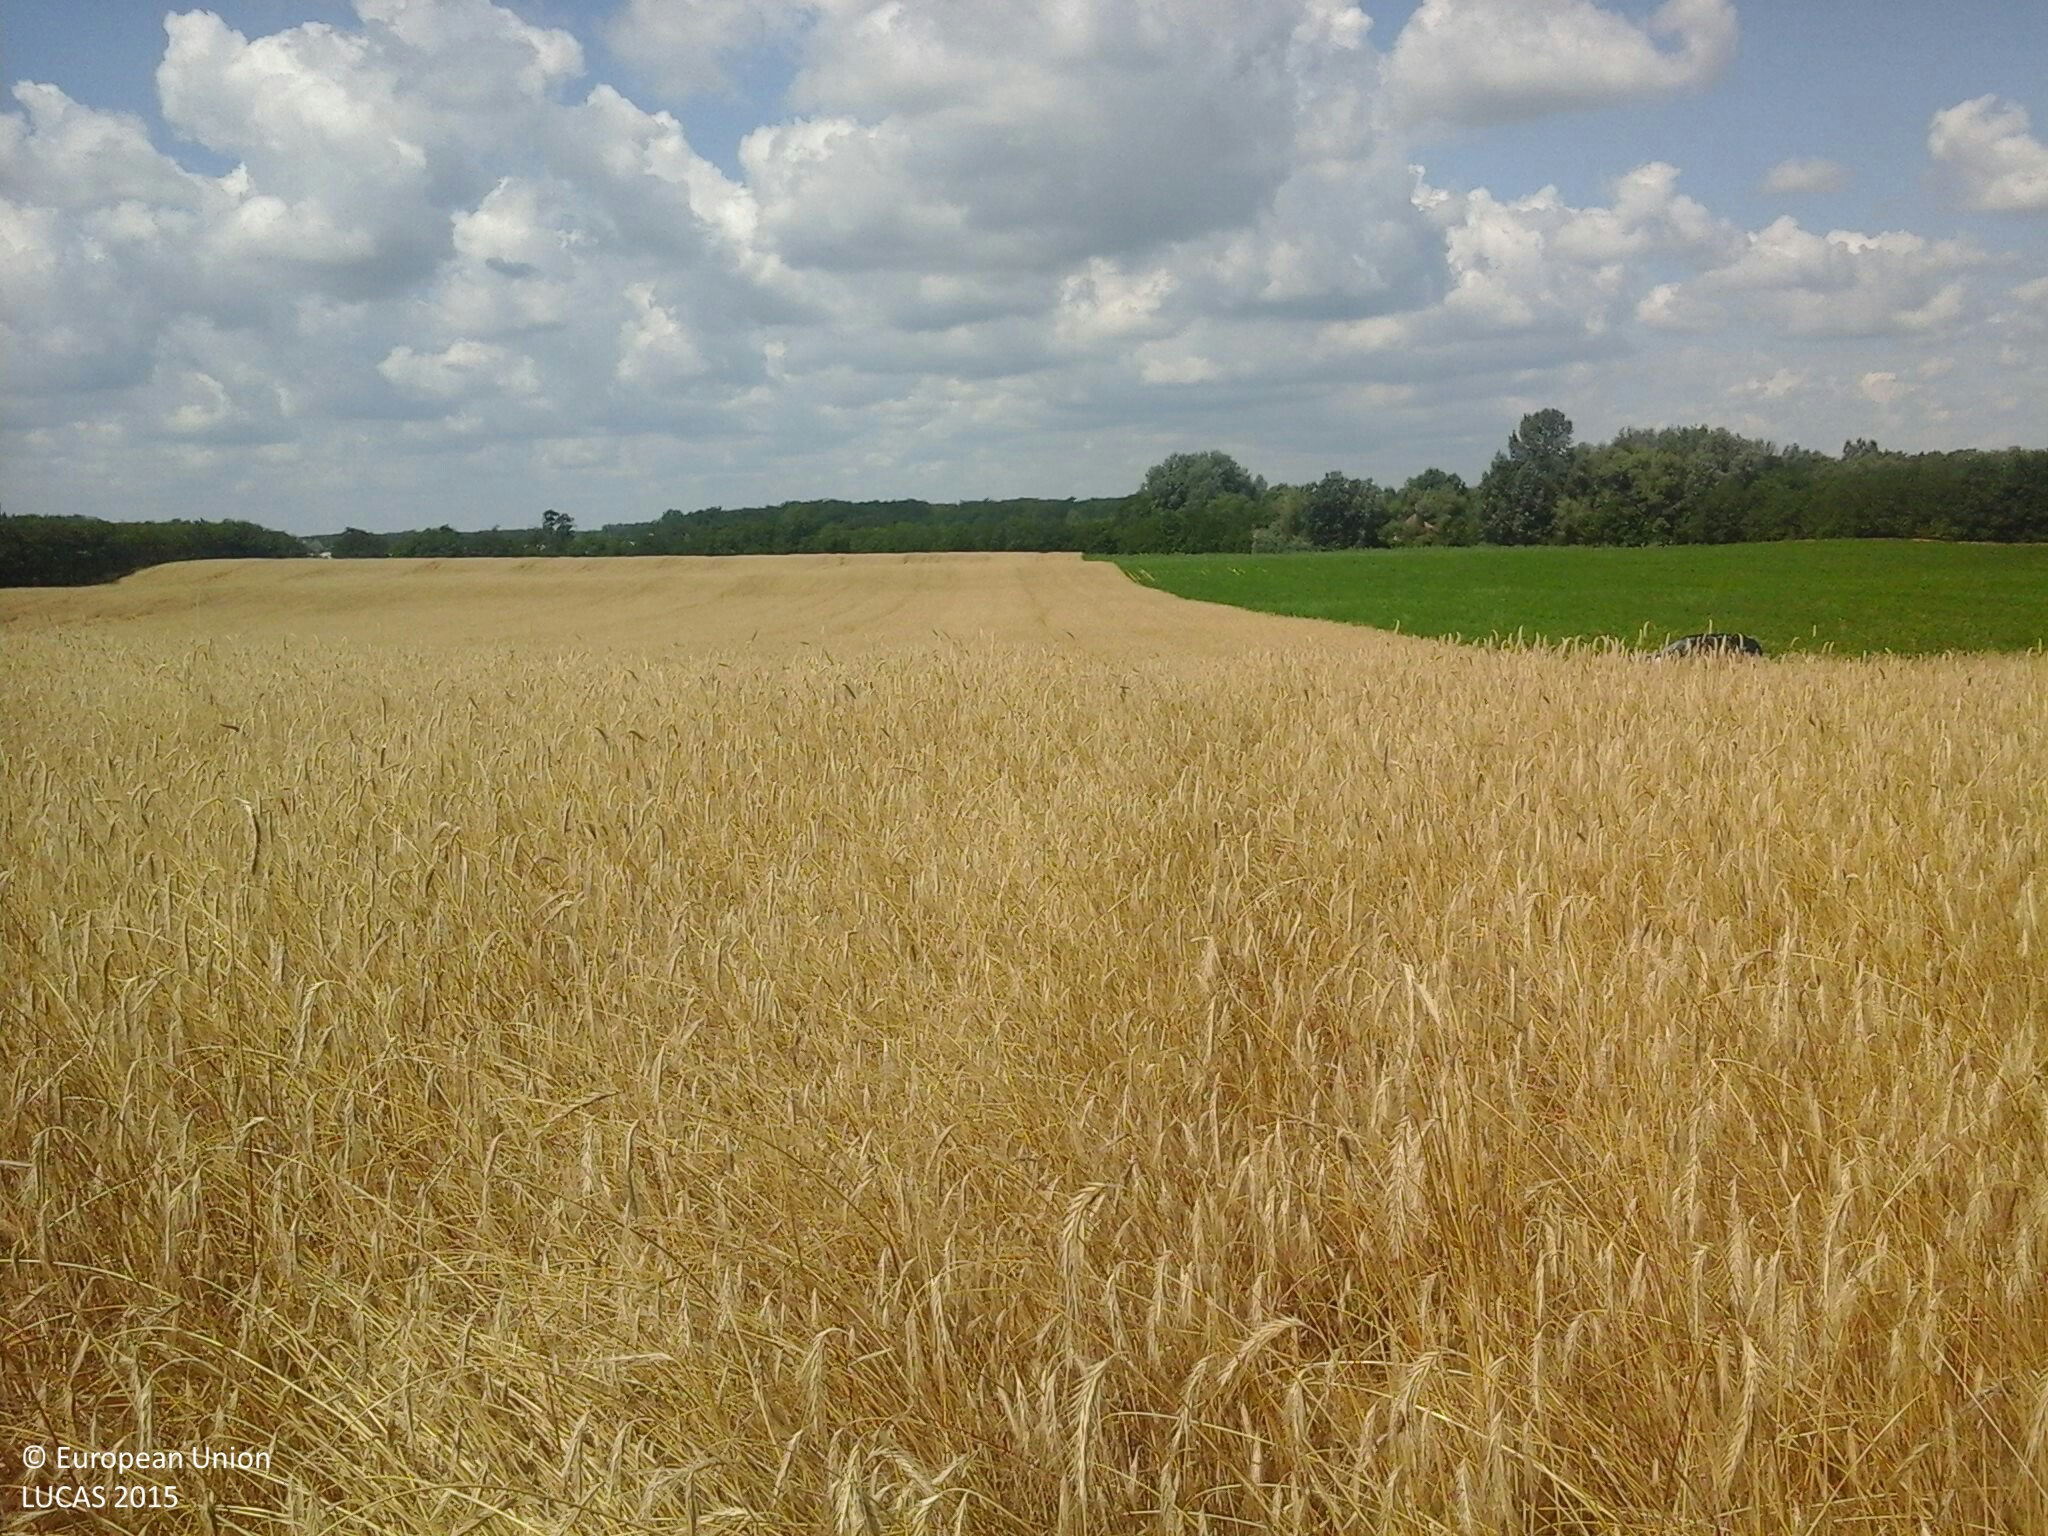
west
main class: Cropland
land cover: Triticale
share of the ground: > 75 %
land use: Agriculture (excluding fallow land and kitchen gardens)
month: July
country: HU
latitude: 47.8815
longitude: 22.2641
